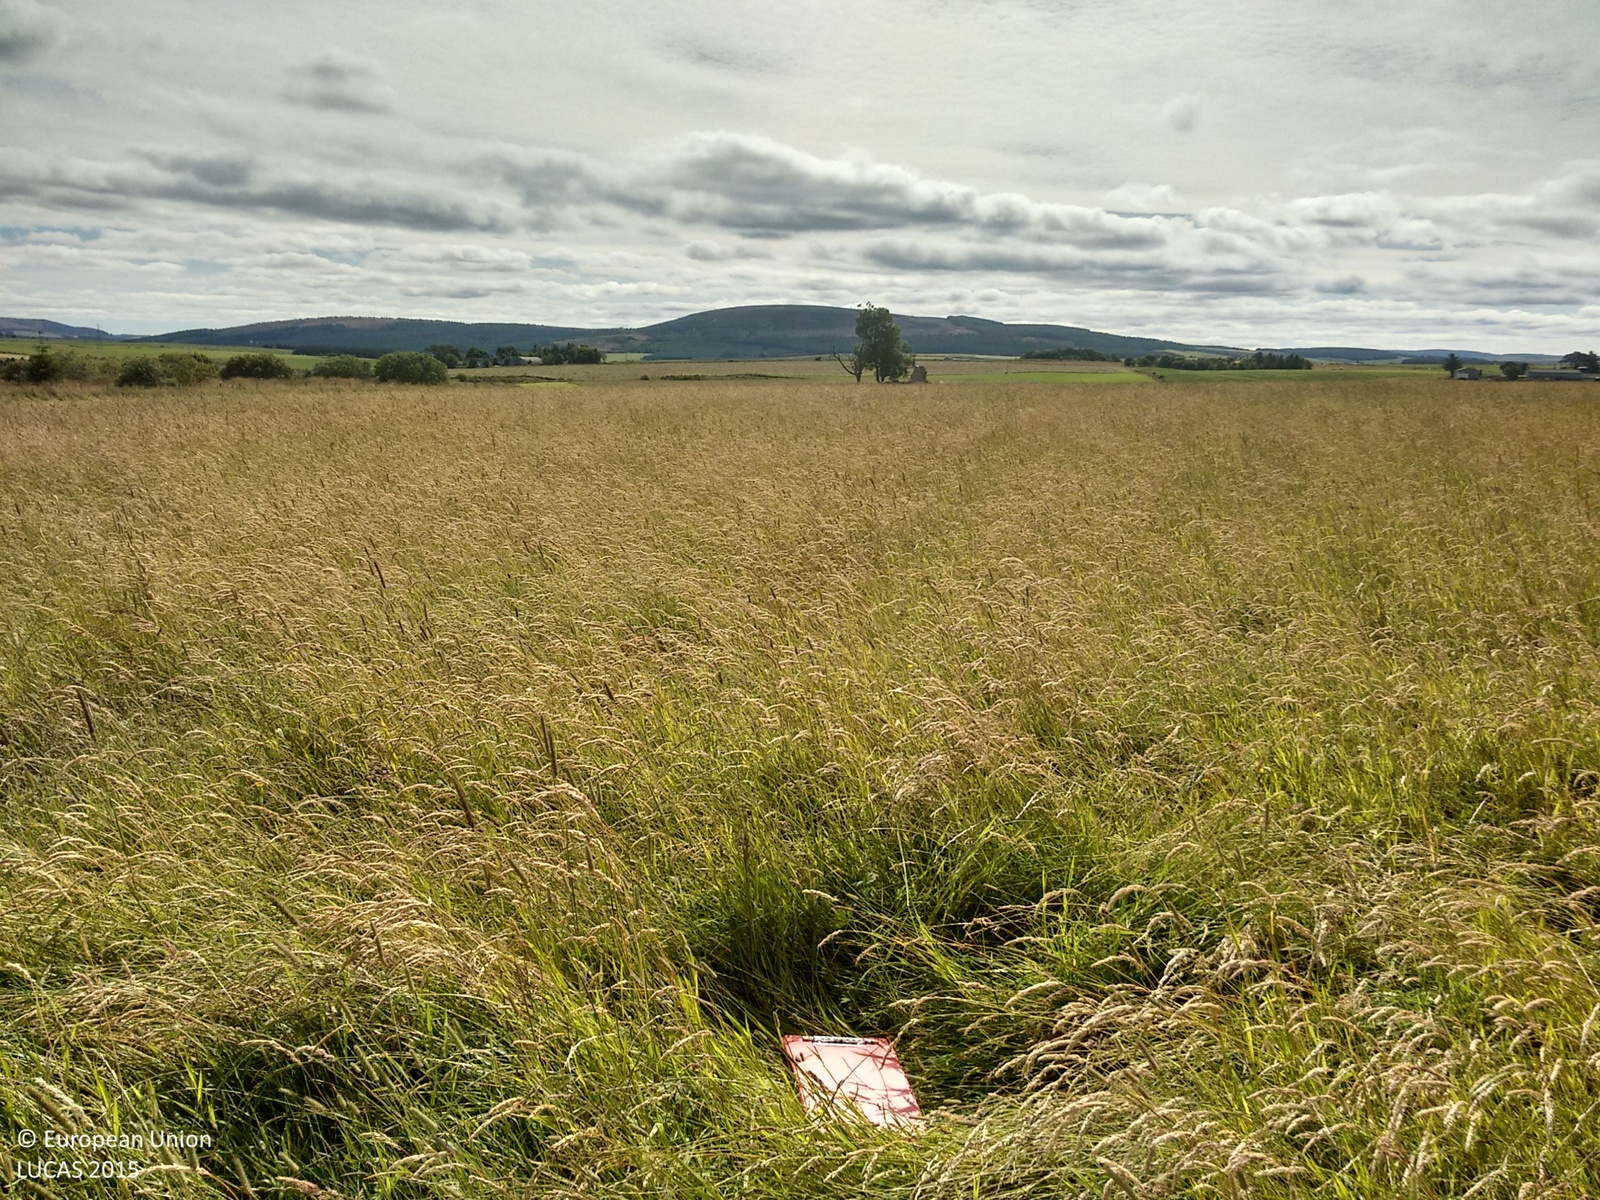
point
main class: Grassland
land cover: Grassland without tree/shrub cover
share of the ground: > 75 %
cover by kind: herbaceous plants 100 %
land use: Agriculture (excluding fallow land and kitchen gardens)
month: August
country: GB
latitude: 57.5744
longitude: -2.9180
